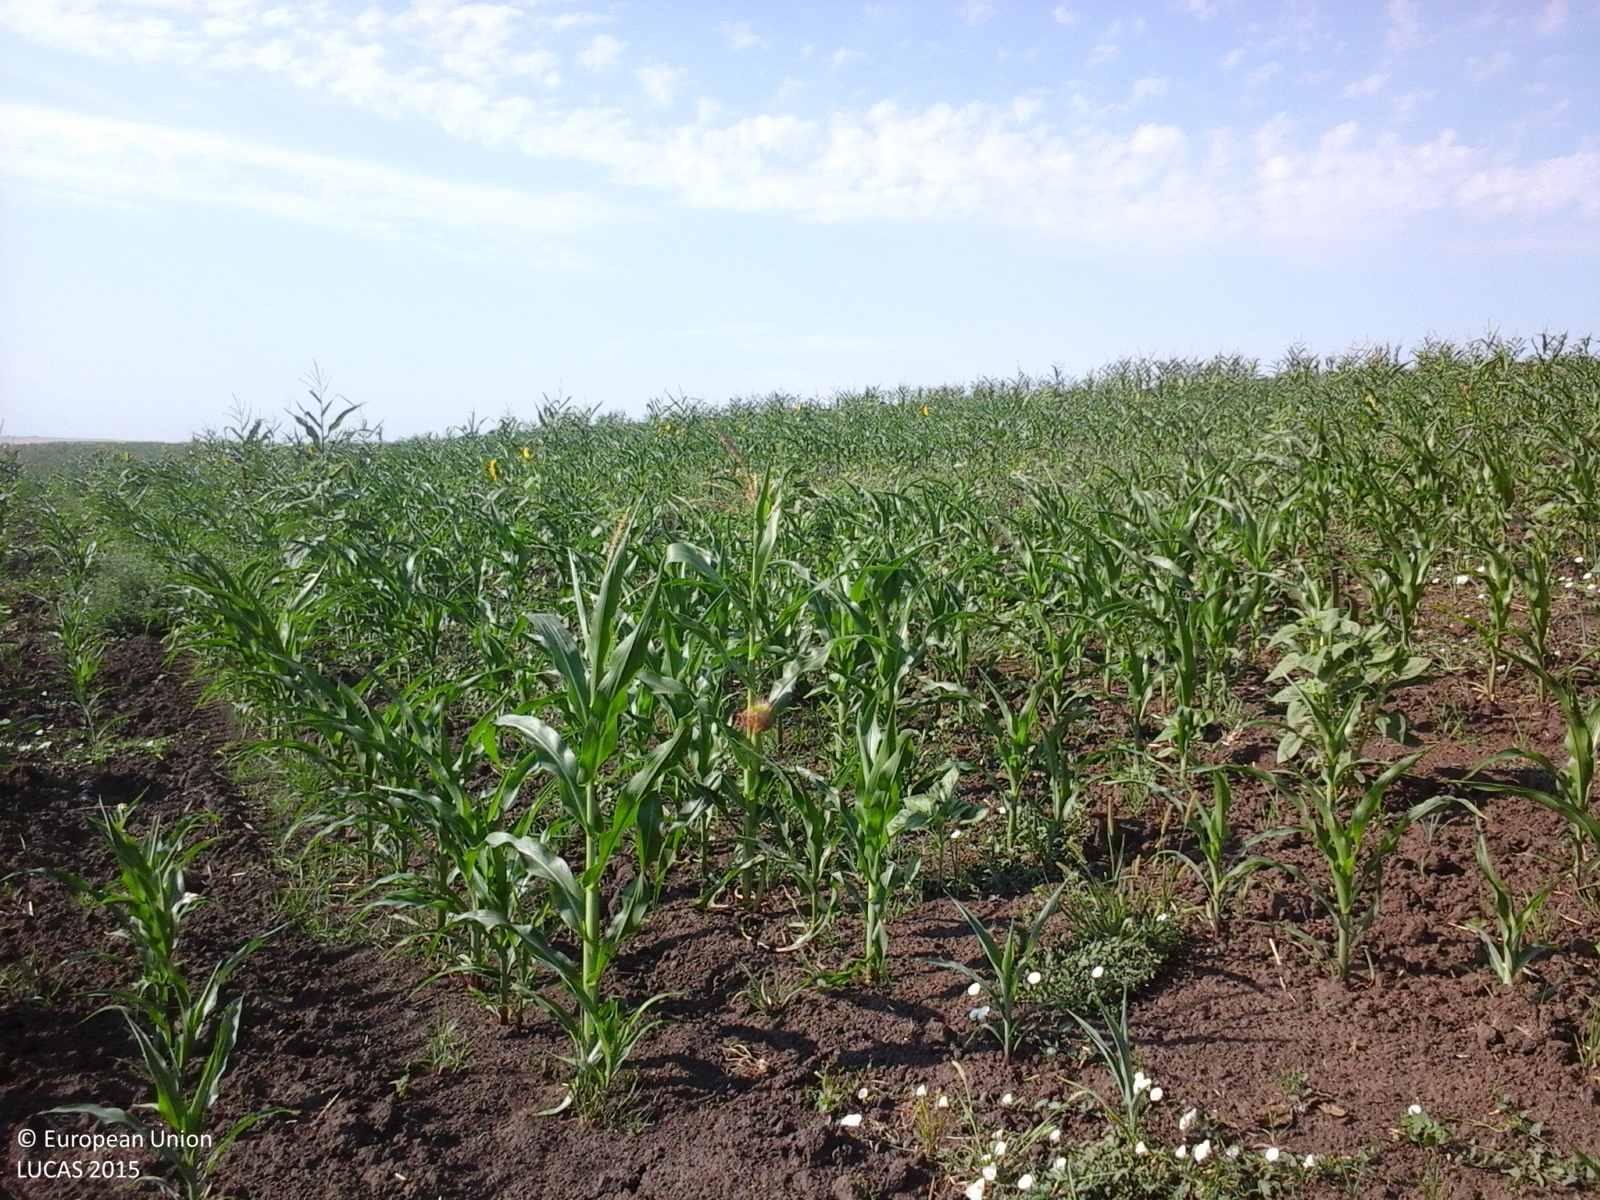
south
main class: Cropland
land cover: Maize
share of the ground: 50 - 75 %
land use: Agriculture (excluding fallow land and kitchen gardens)
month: July
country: RO
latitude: 46.2747
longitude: 28.0470
